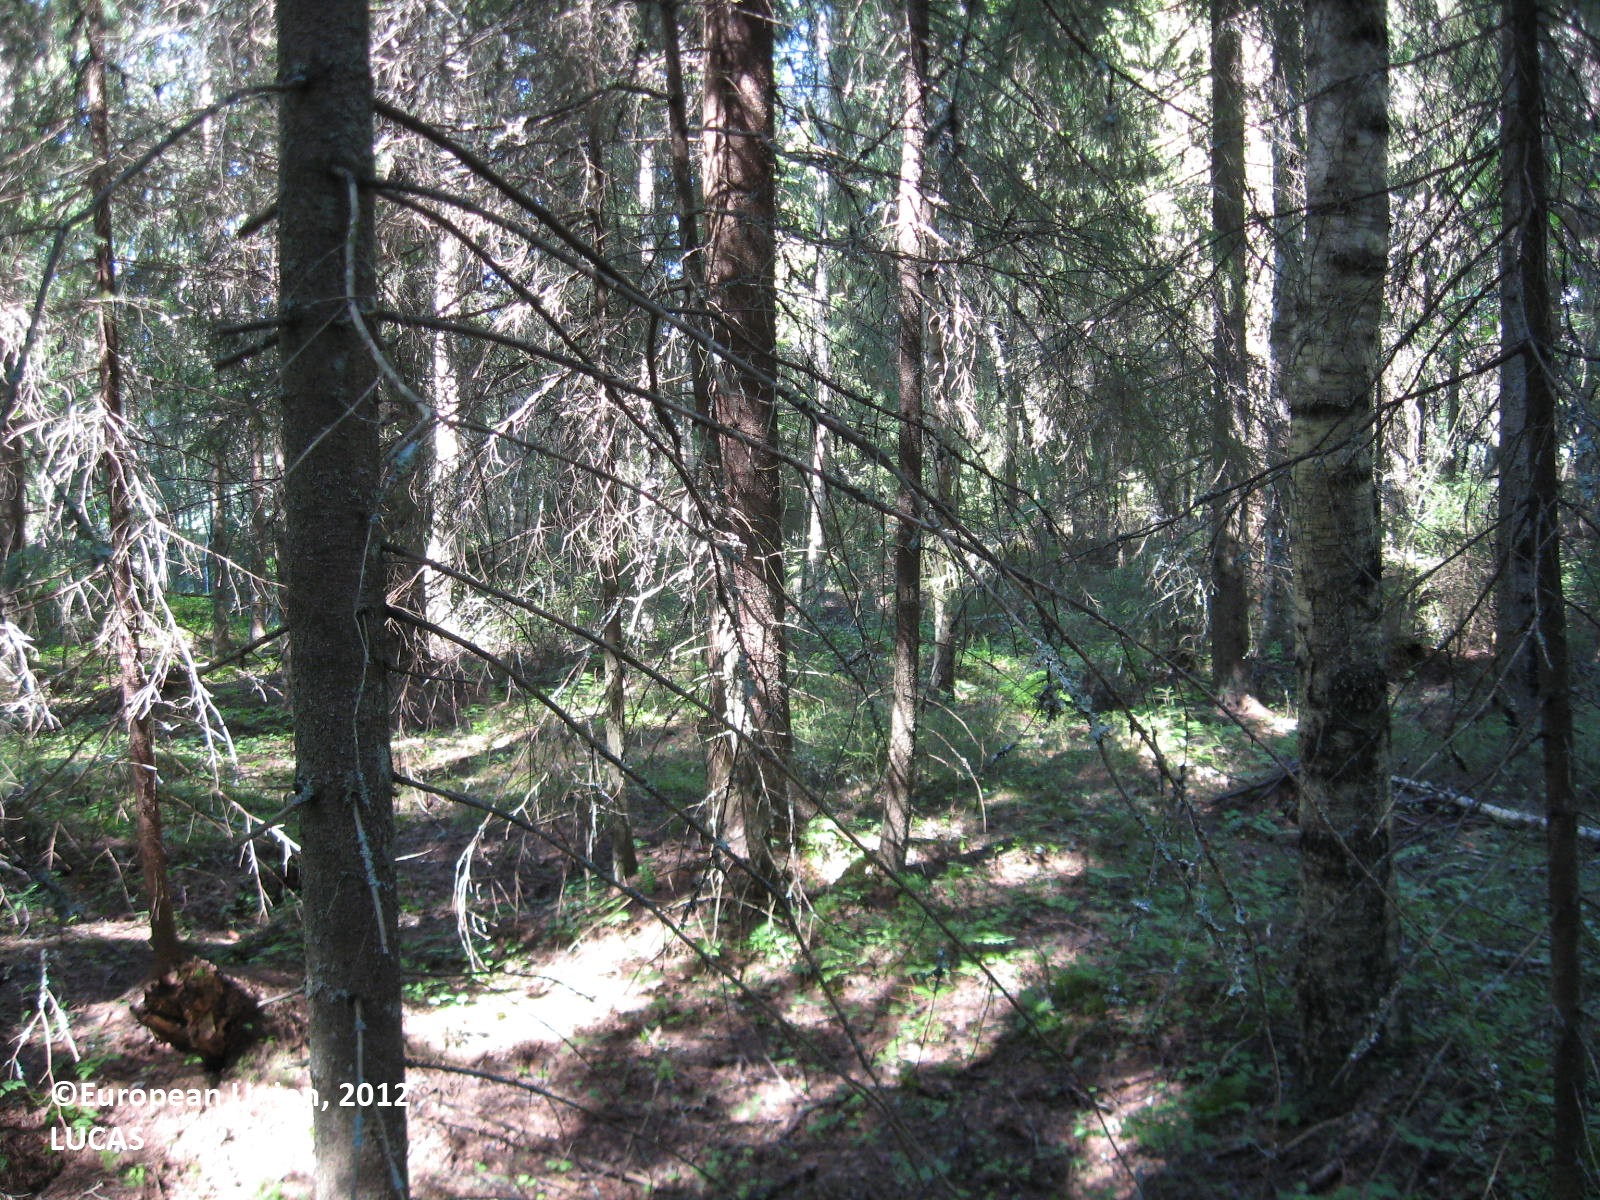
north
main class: Woodland
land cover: Spruce dominated coniferous woodland
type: boreal forest
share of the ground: > 75 %
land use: Forestry
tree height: > 5 m
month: July
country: FI
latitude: 62.1933
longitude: 21.6730
